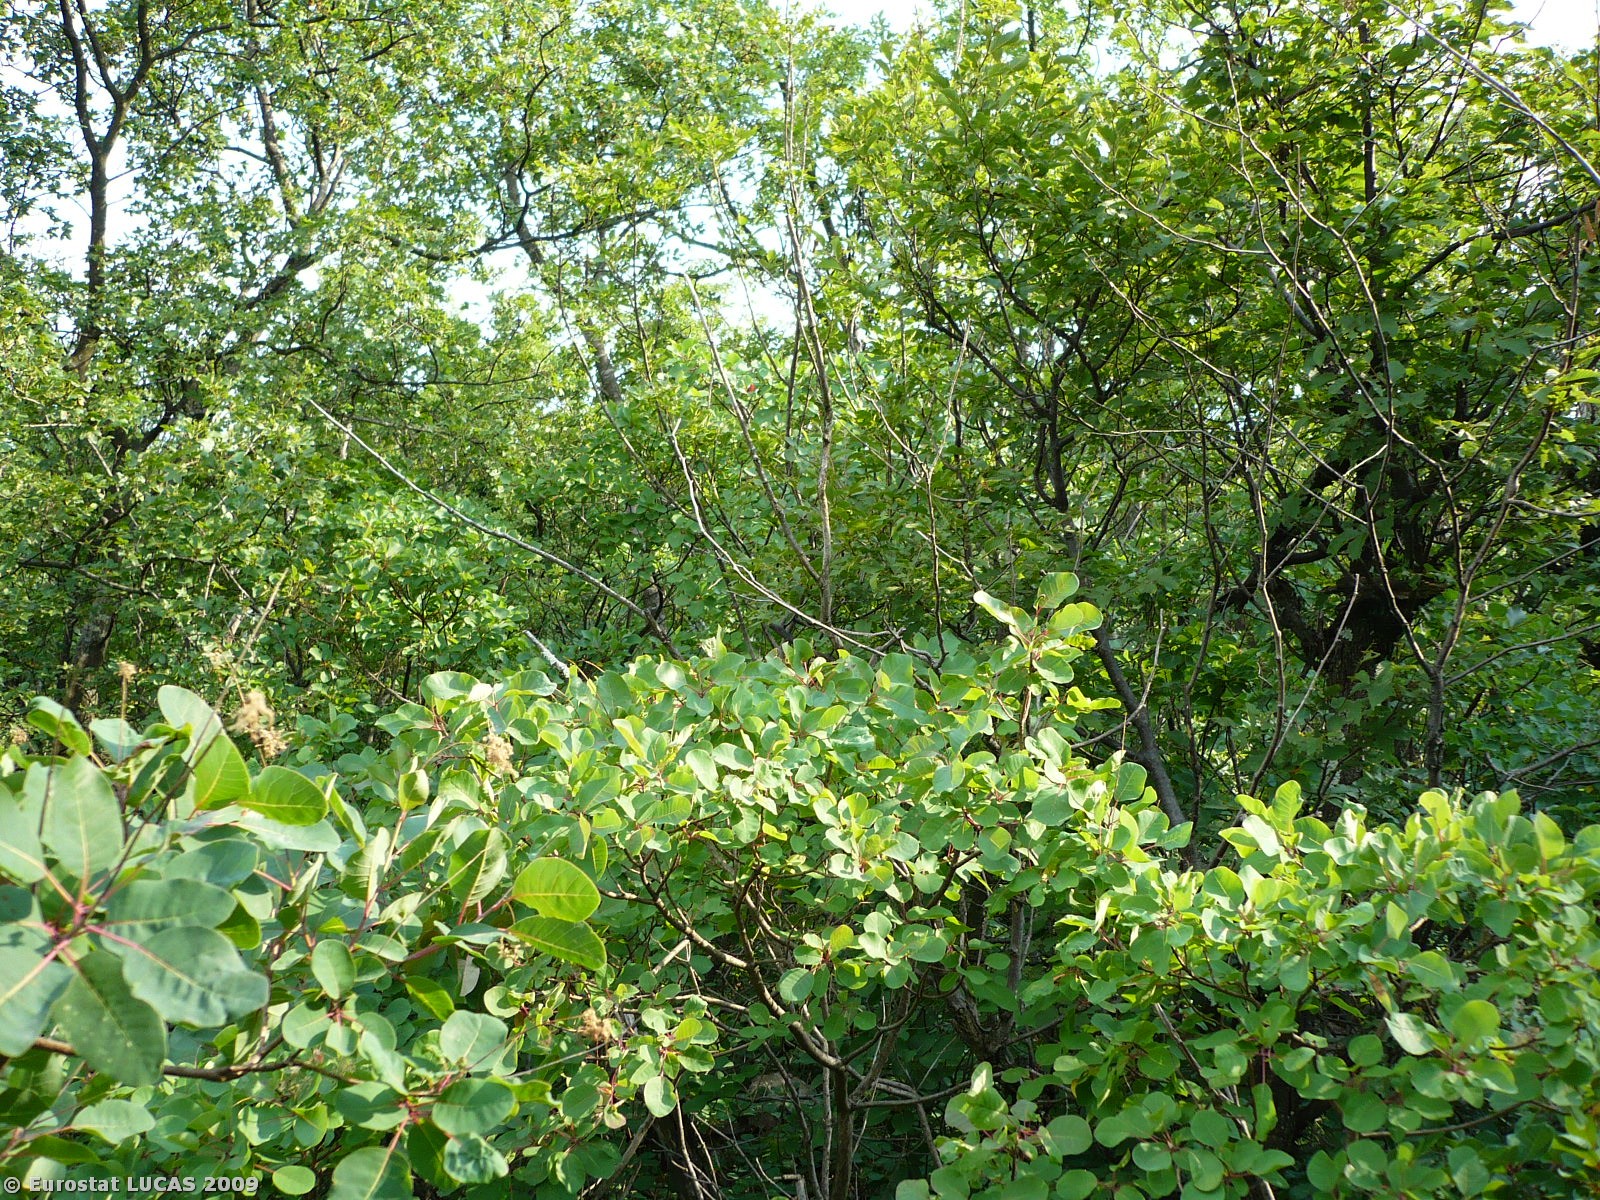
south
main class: Woodland
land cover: Broadleaved woodland
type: thermophilous deciduous forest
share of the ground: > 75 %
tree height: > 5 m
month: July
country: SI
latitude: 45.8016
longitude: 13.6628
